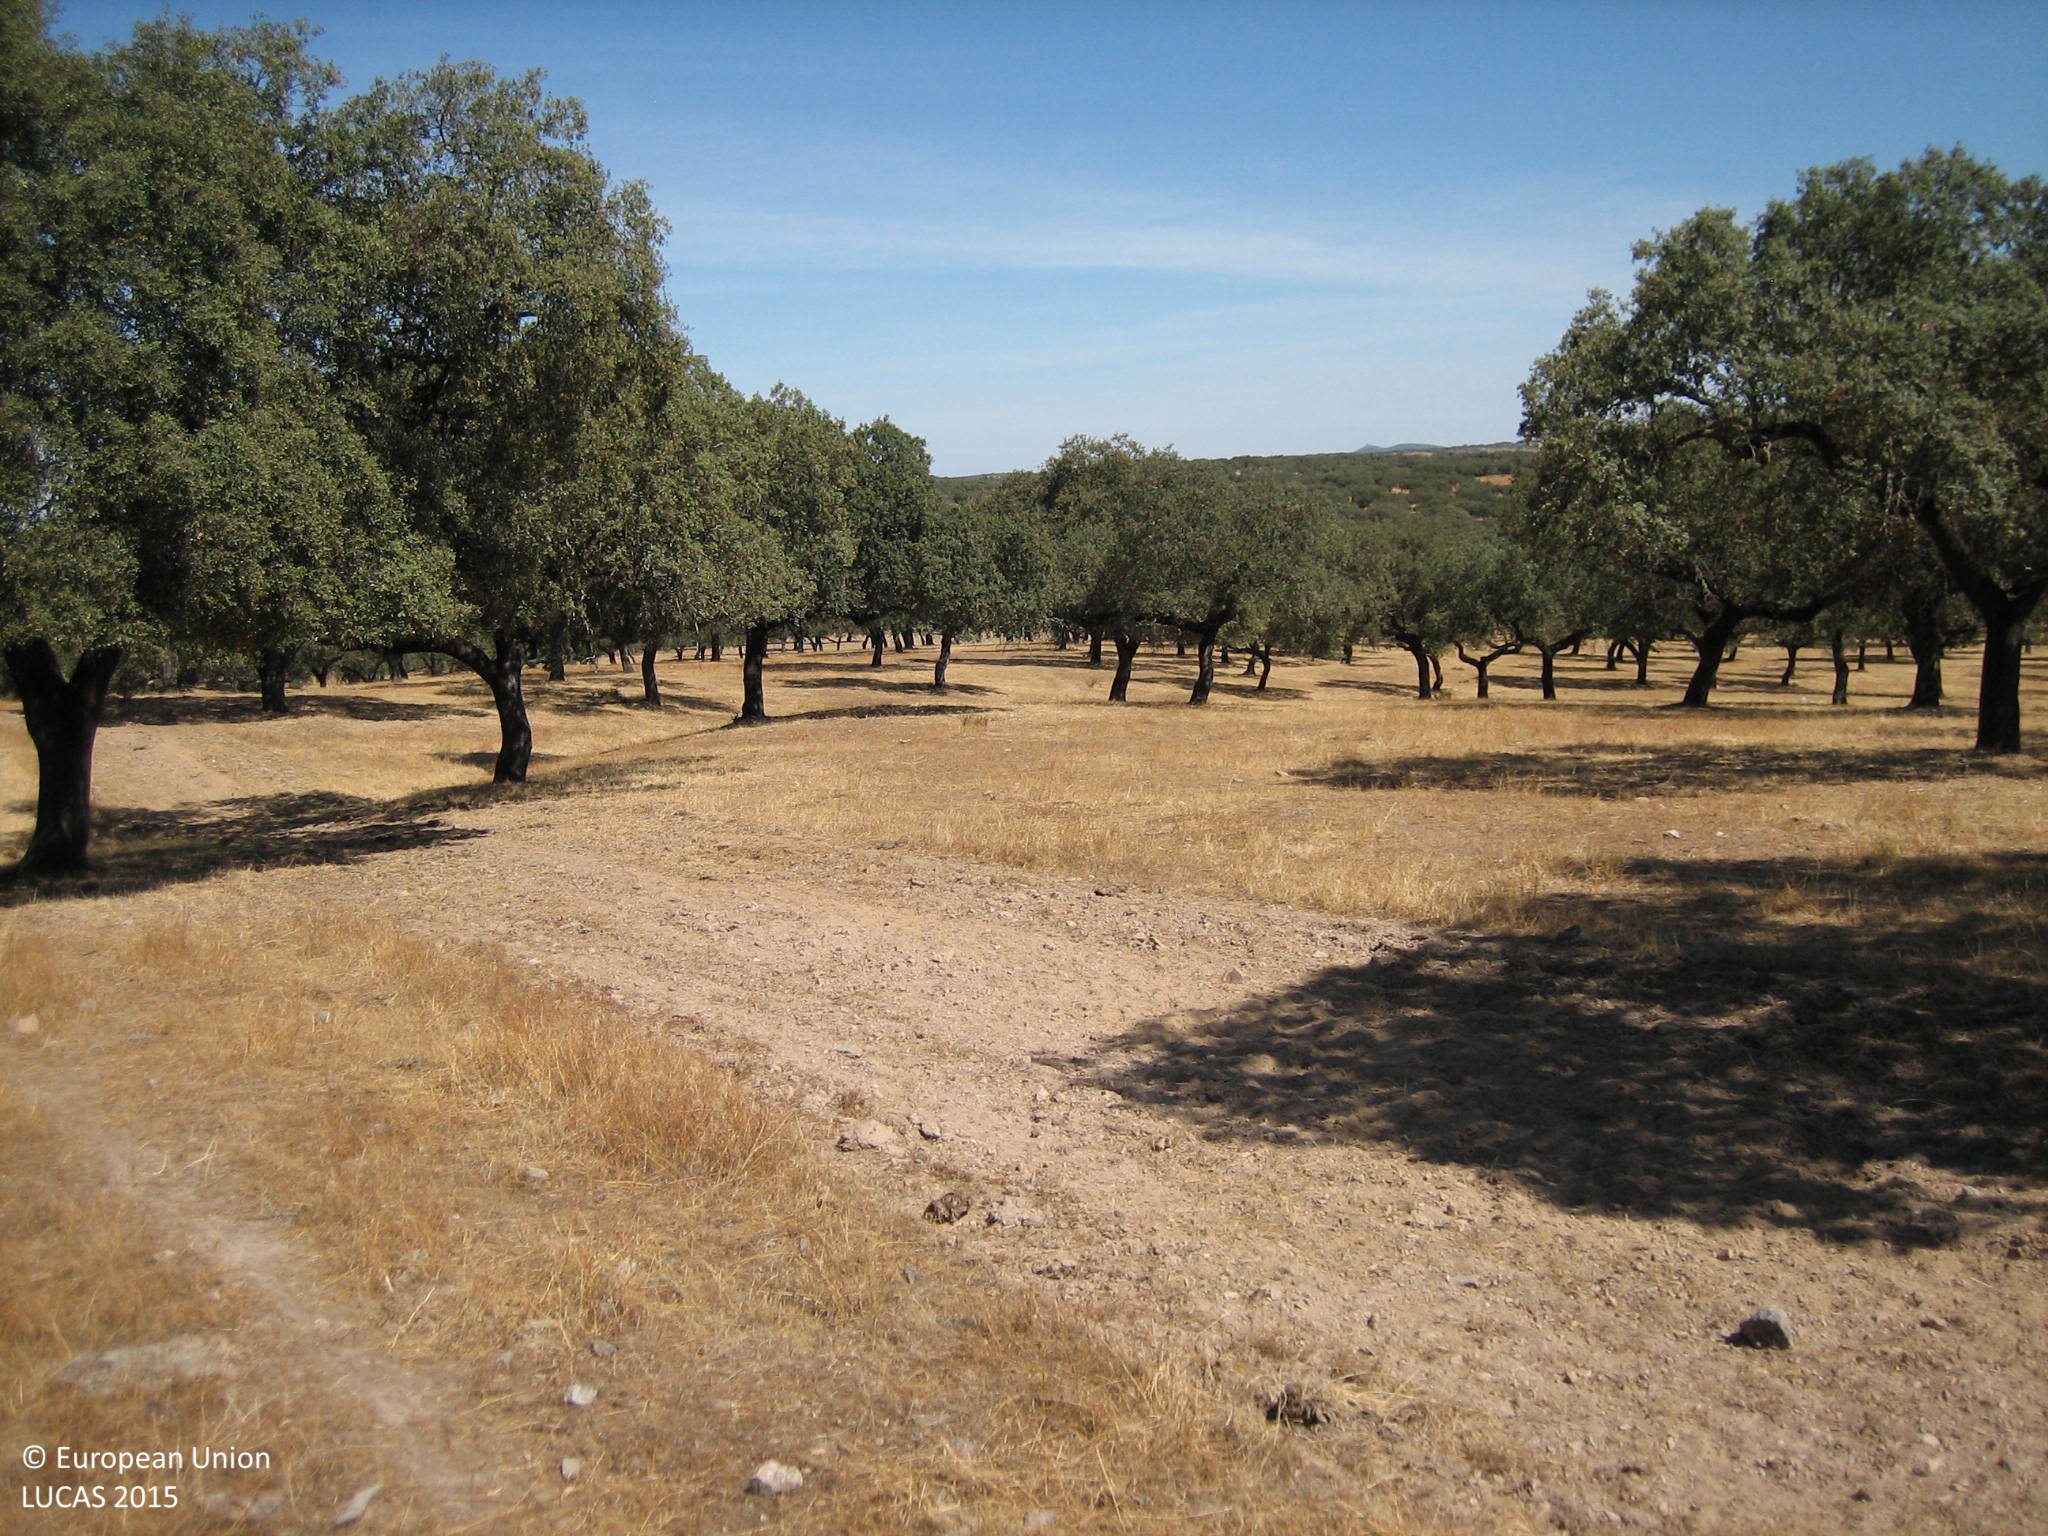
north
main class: Woodland
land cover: Broadleaved woodland
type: broadleaved evergreen forest
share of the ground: 10 - 25 %
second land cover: Grassland without tree/shrub cover
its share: 50 - 75 %
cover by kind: herbaceous plants 60 %, unconsolidated bare surface 30 %, broadleaved forest trees 10 %
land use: Forestry
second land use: Agriculture (excluding fallow land and kitchen gardens)
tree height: > 5 m
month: August
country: ES
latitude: 38.4980
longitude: -7.1862
